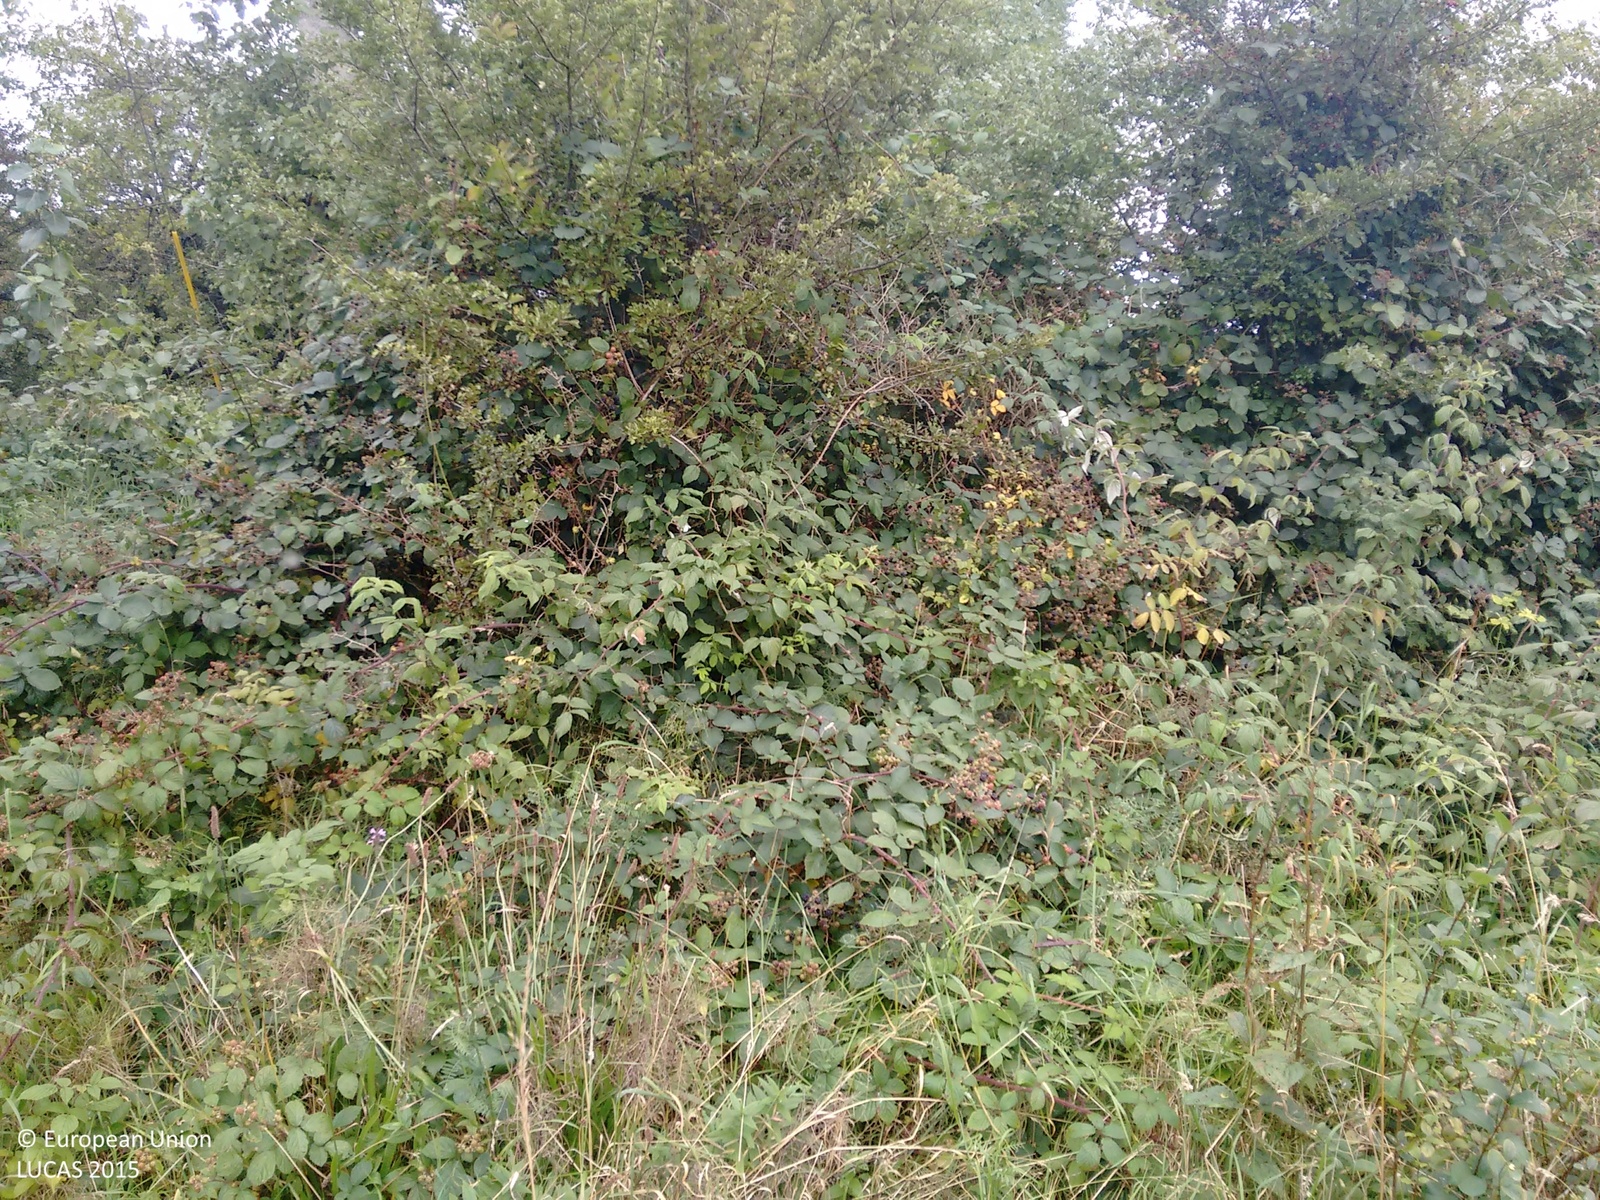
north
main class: Grassland
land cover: Grassland without tree/shrub cover
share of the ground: > 75 %
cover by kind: herbaceous plants 100 %
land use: Agriculture (excluding fallow land and kitchen gardens)
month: September
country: IE
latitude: 54.1290
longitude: -6.7993
